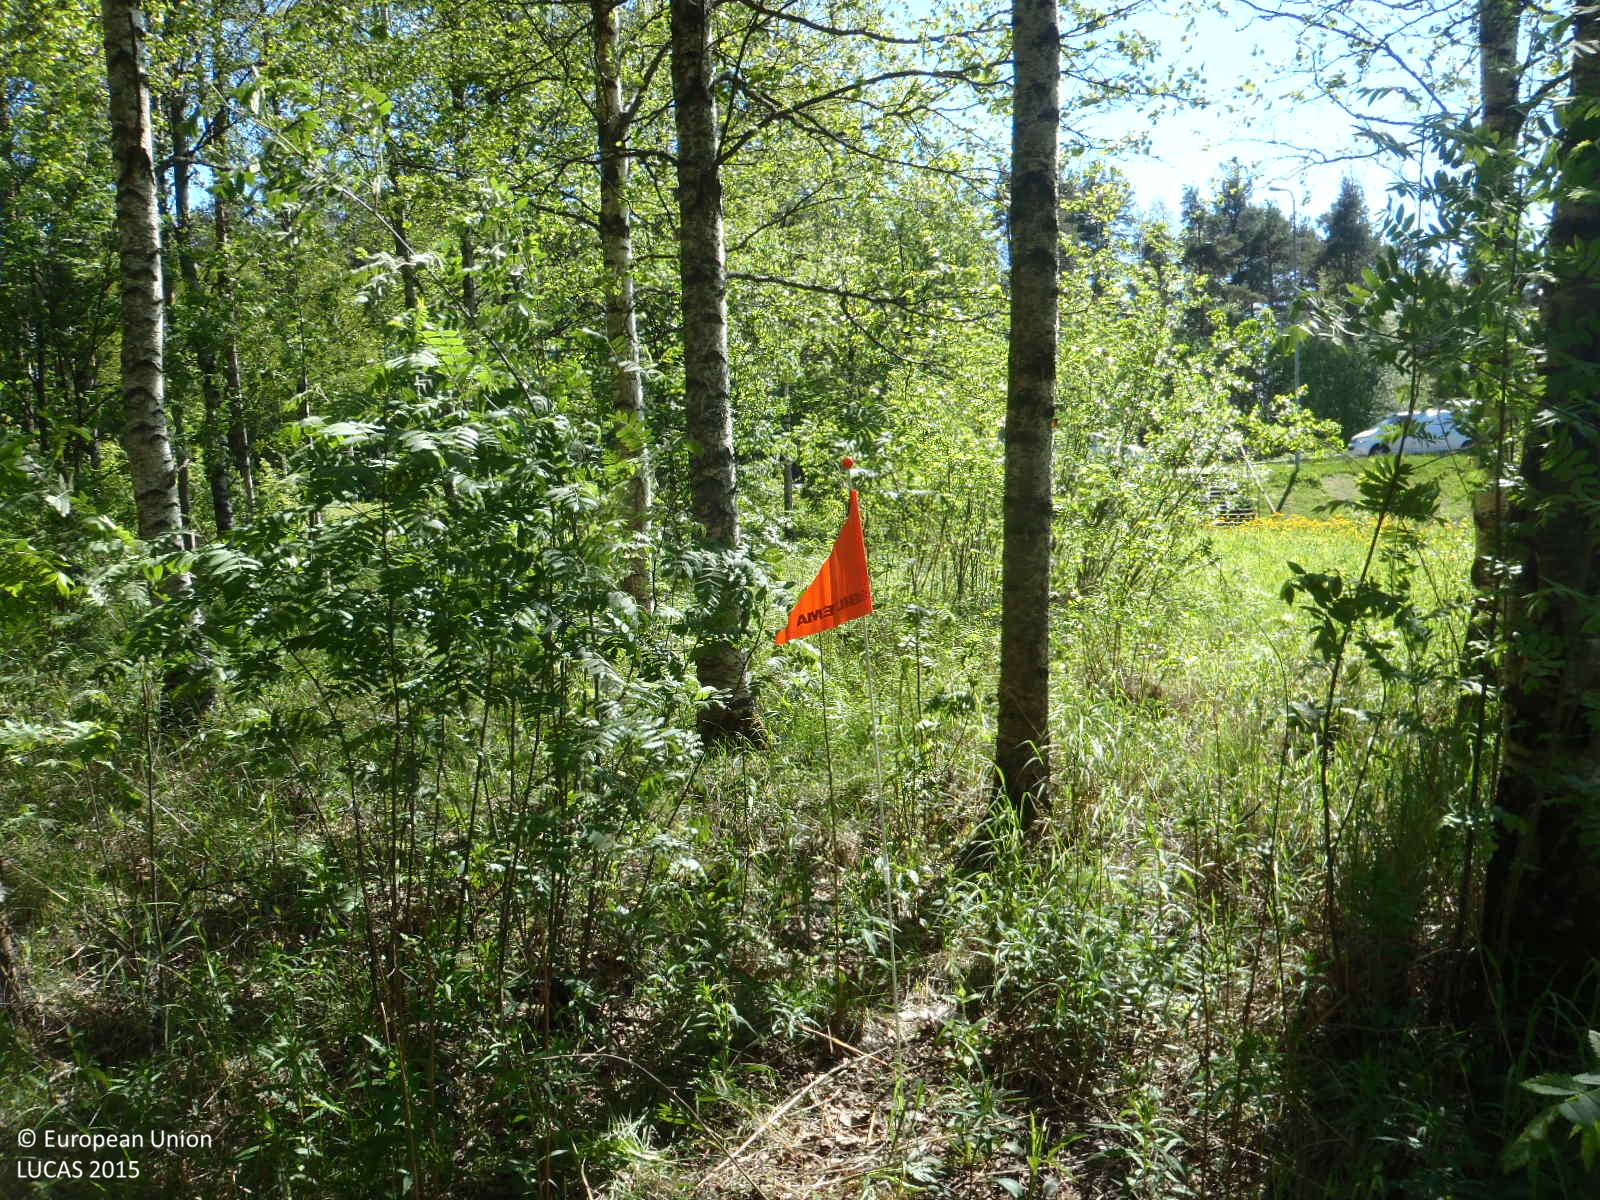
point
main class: Woodland
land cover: Other mixed woodland
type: boreal forest
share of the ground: 50 - 75 %
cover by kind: broadleaved forest trees 40 %, herbaceous plants 30 %, coniferous forest trees 20 %, shrubs 10 %
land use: Amenities, museums, leisure
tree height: > 5 m
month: June
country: FI
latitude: 64.9983
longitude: 25.5001
